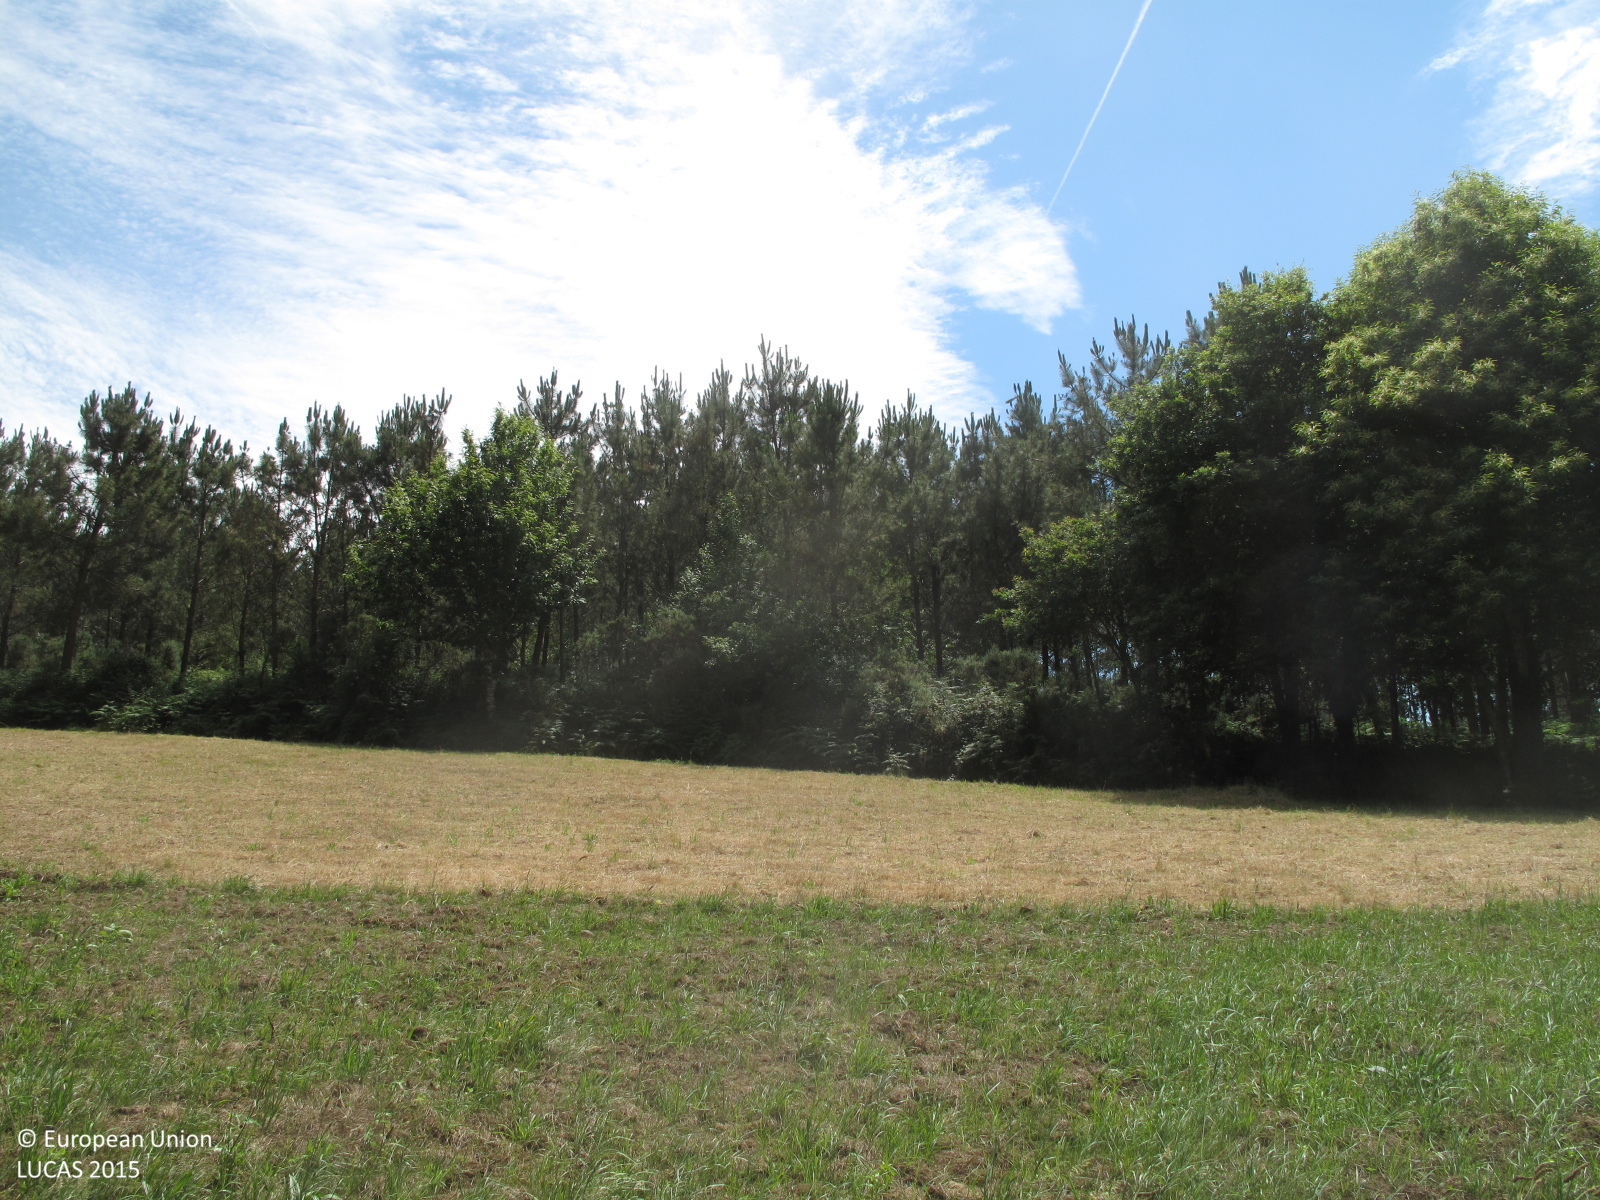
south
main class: Grassland
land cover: Grassland without tree/shrub cover
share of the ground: 50 - 75 %
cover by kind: herbaceous plants 70 %, unconsolidated bare surface 30 %
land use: Agriculture (excluding fallow land and kitchen gardens)
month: July
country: ES
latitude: 43.1856
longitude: -8.6034
